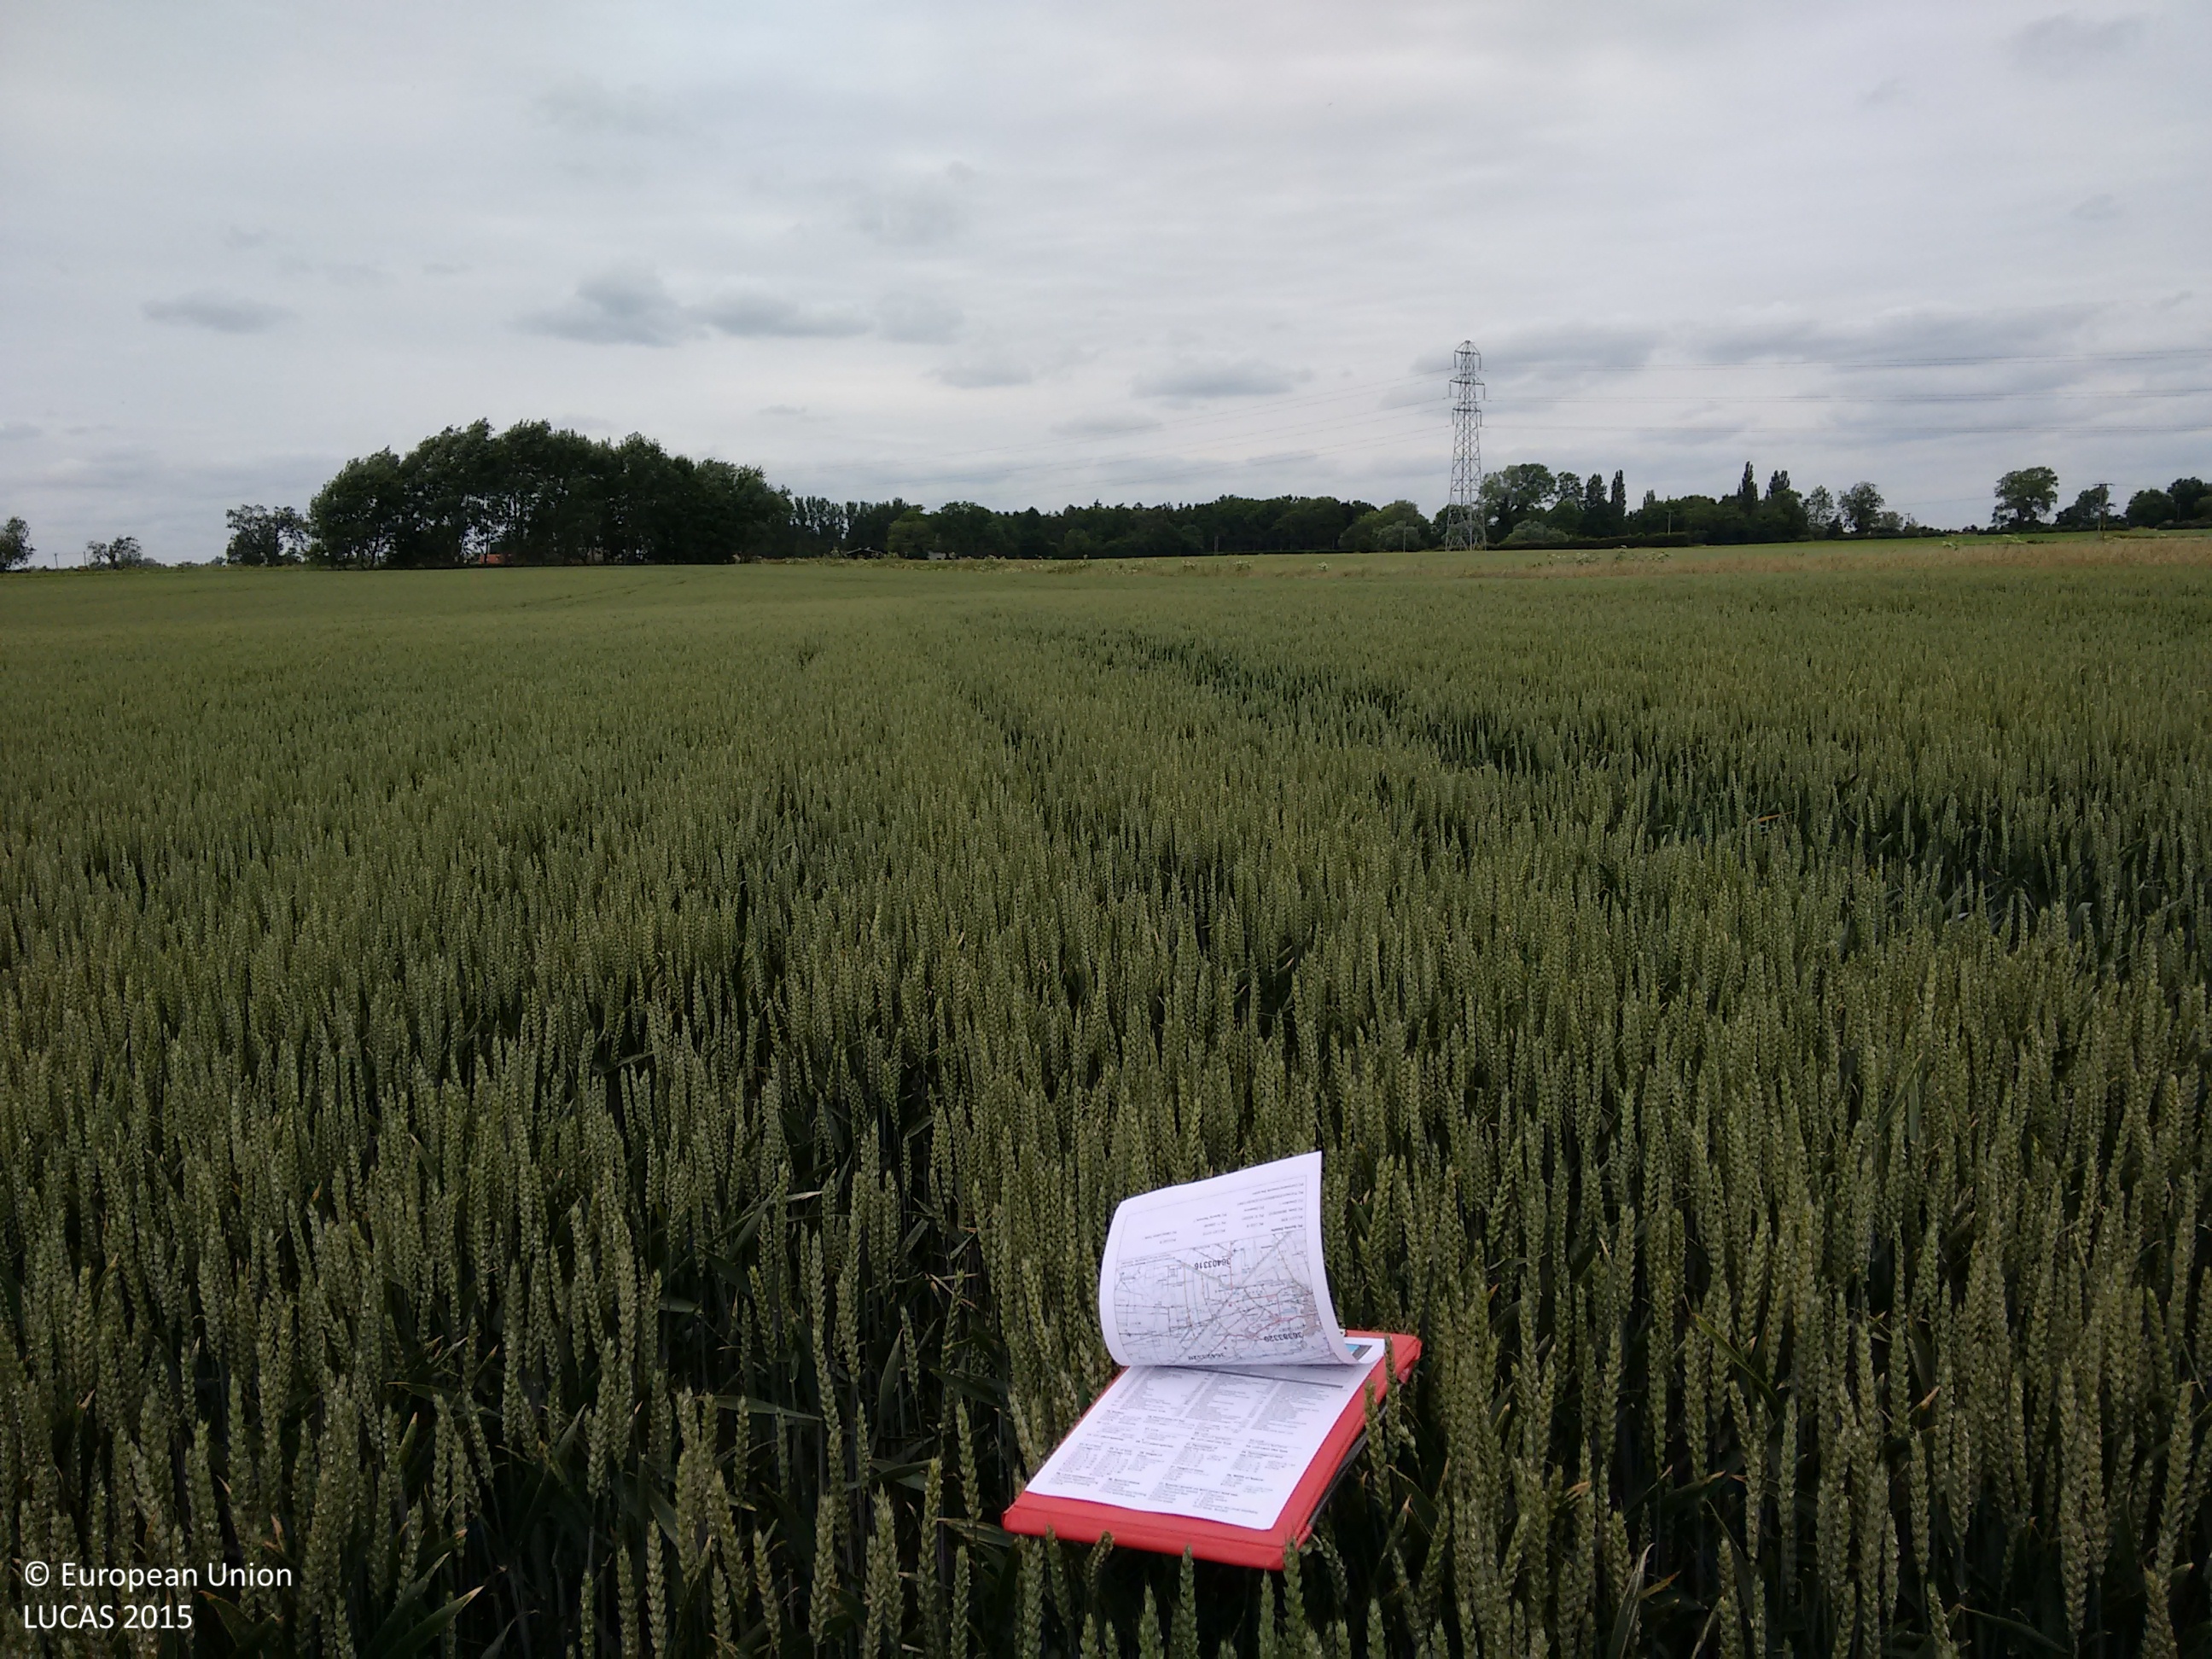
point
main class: Cropland
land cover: Common wheat
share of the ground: > 75 %
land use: Agriculture (excluding fallow land and kitchen gardens)
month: June
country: GB
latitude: 52.5660
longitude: -0.0503
